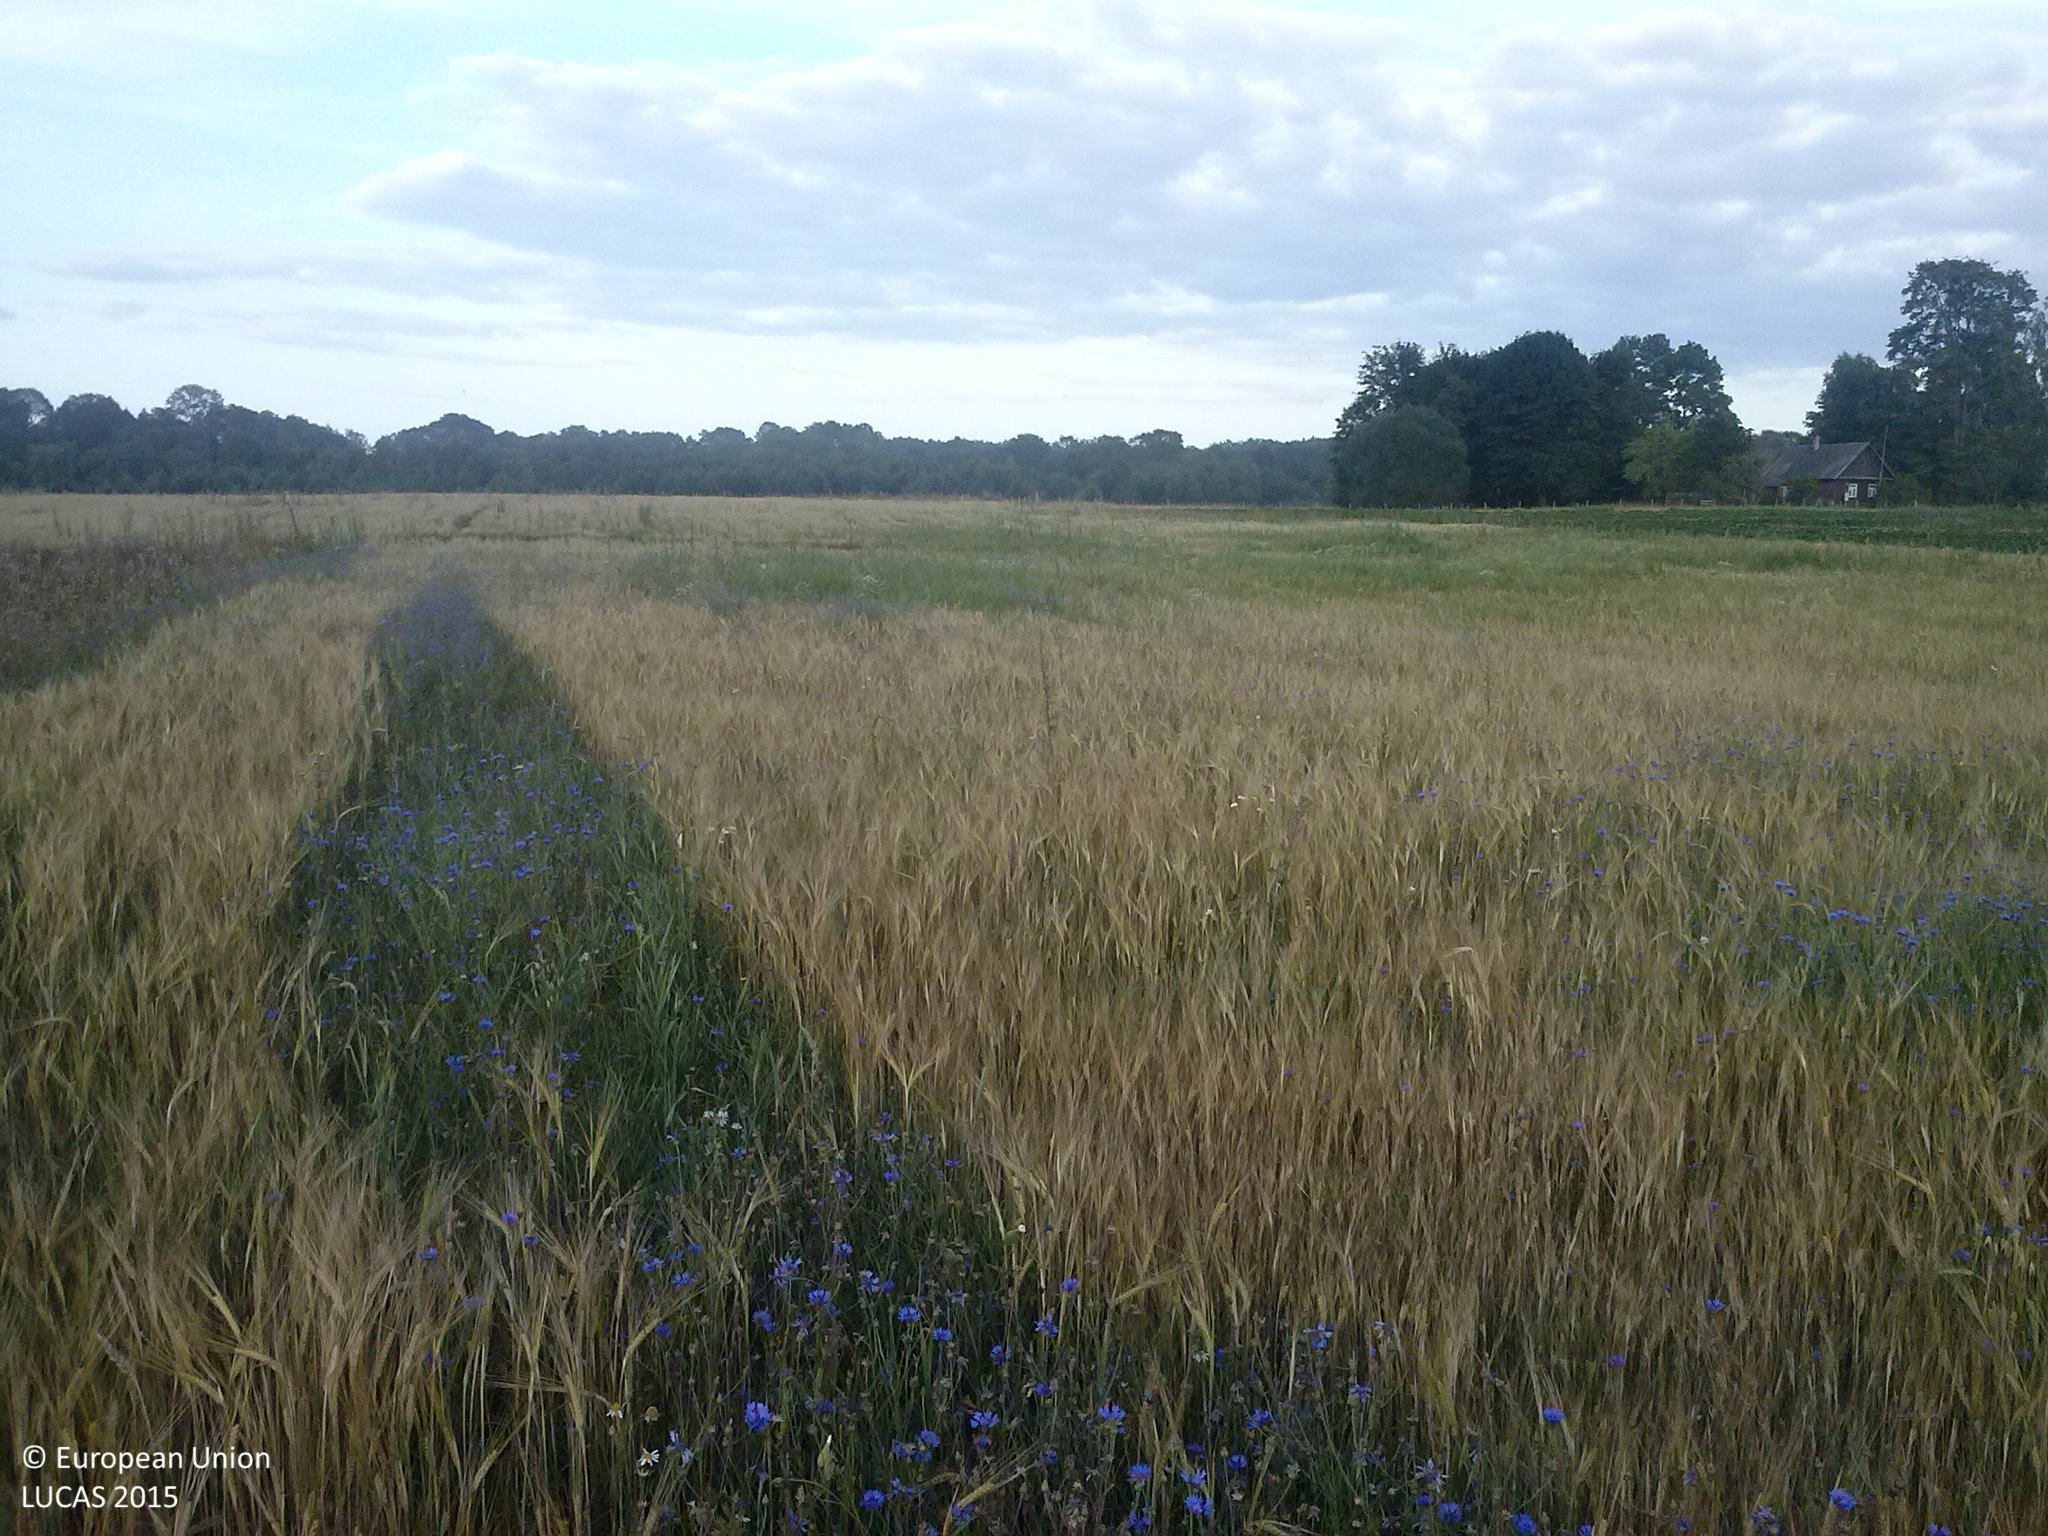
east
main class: Cropland
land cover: Barley
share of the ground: > 75 %
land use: Agriculture (excluding fallow land and kitchen gardens)
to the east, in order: Barley
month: July
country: LV
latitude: 56.5951
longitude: 26.9521
